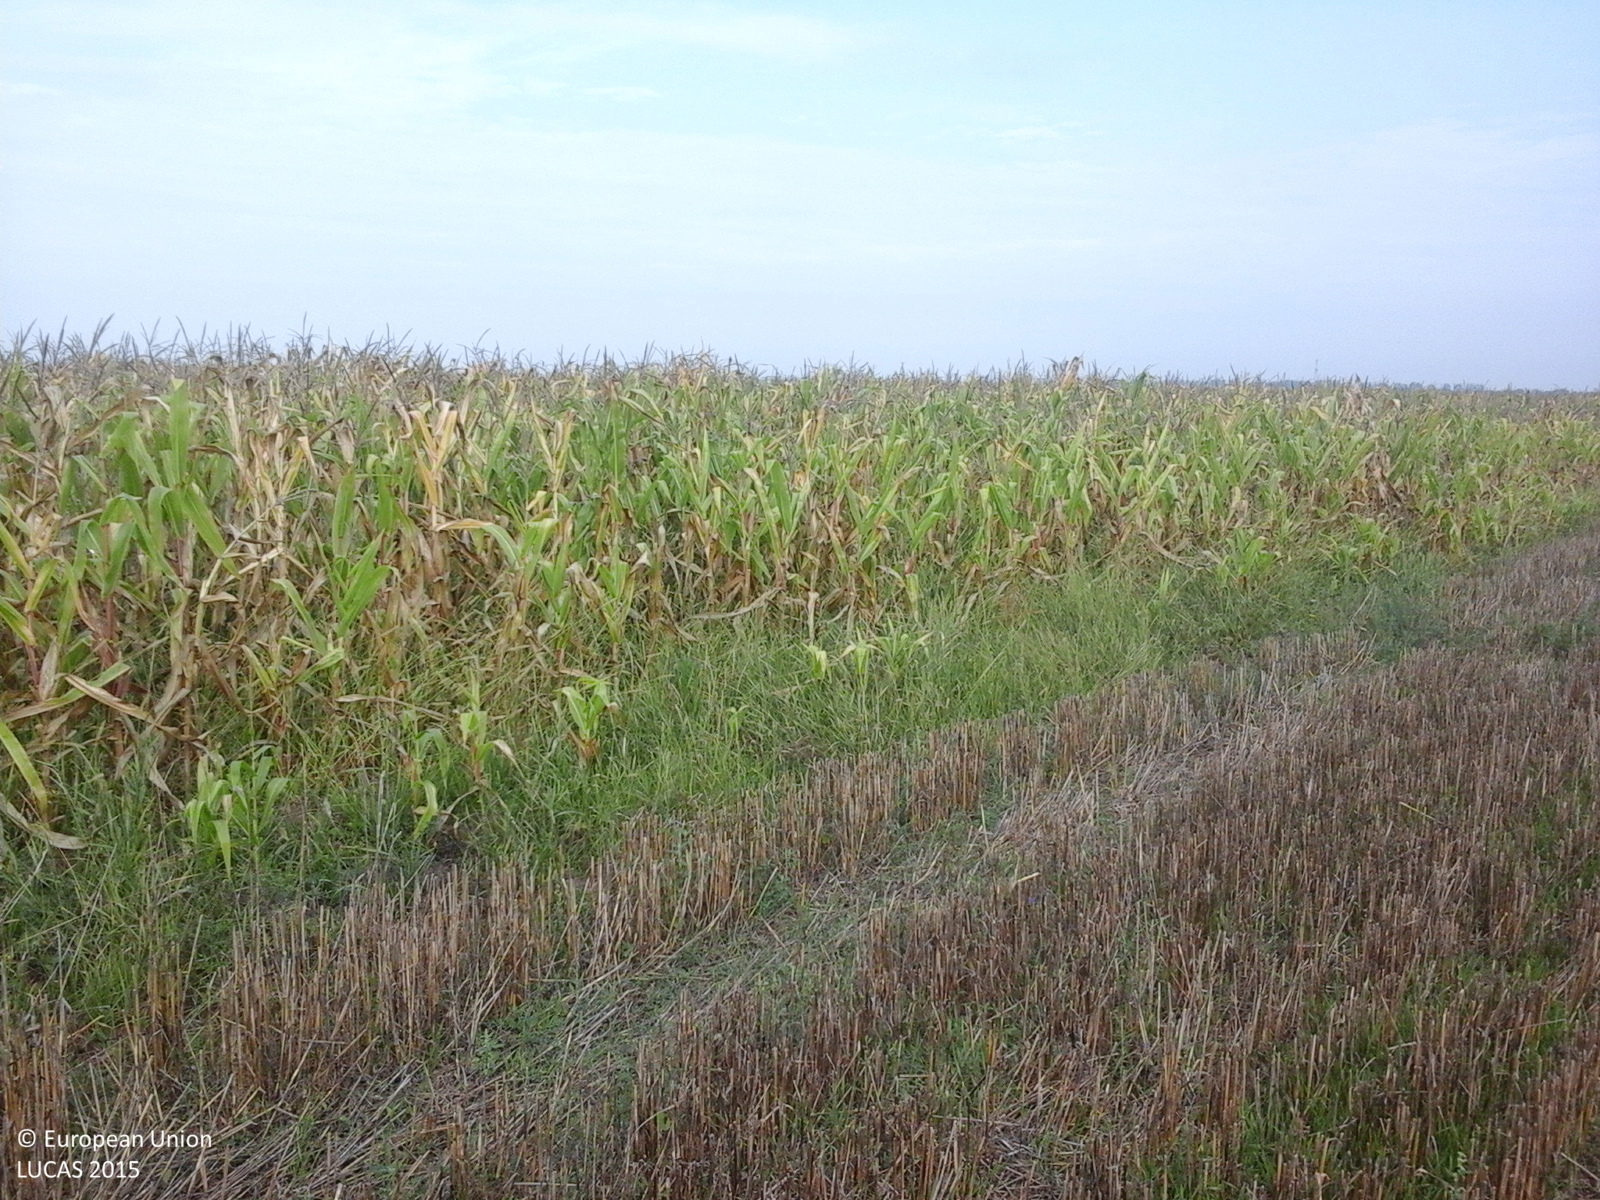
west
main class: Cropland
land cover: Durum wheat
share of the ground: > 75 %
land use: Agriculture (excluding fallow land and kitchen gardens)
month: August
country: RO
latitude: 46.5357
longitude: 21.6047
